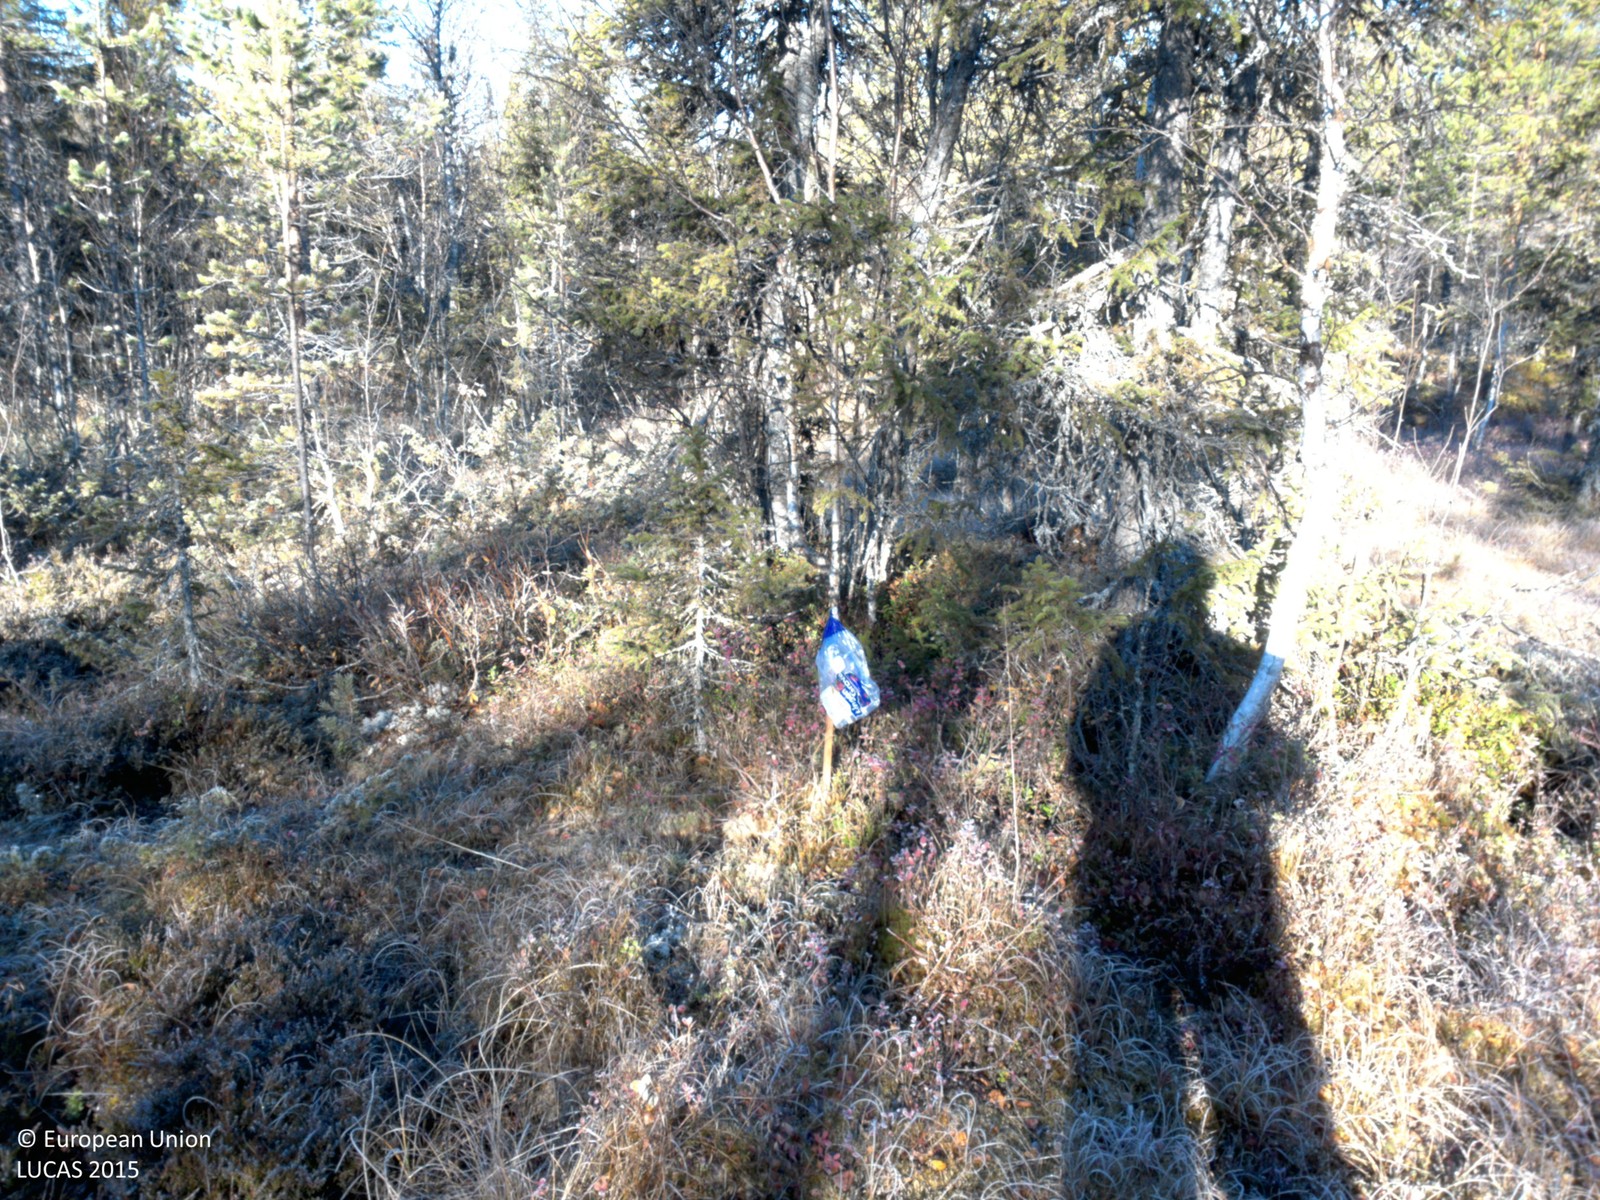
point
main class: Woodland
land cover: Spruce dominated mixed woodland
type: mire and swamp forests
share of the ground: 25 - 50 %
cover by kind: coniferous forest trees 30 %, shrubs 25 %, broadleaved forest trees 20 %, lichens and mosses 15 %, herbaceous plants 10 %
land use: Forestry
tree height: > 5 m
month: October
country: SE
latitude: 64.7530
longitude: 17.7612
